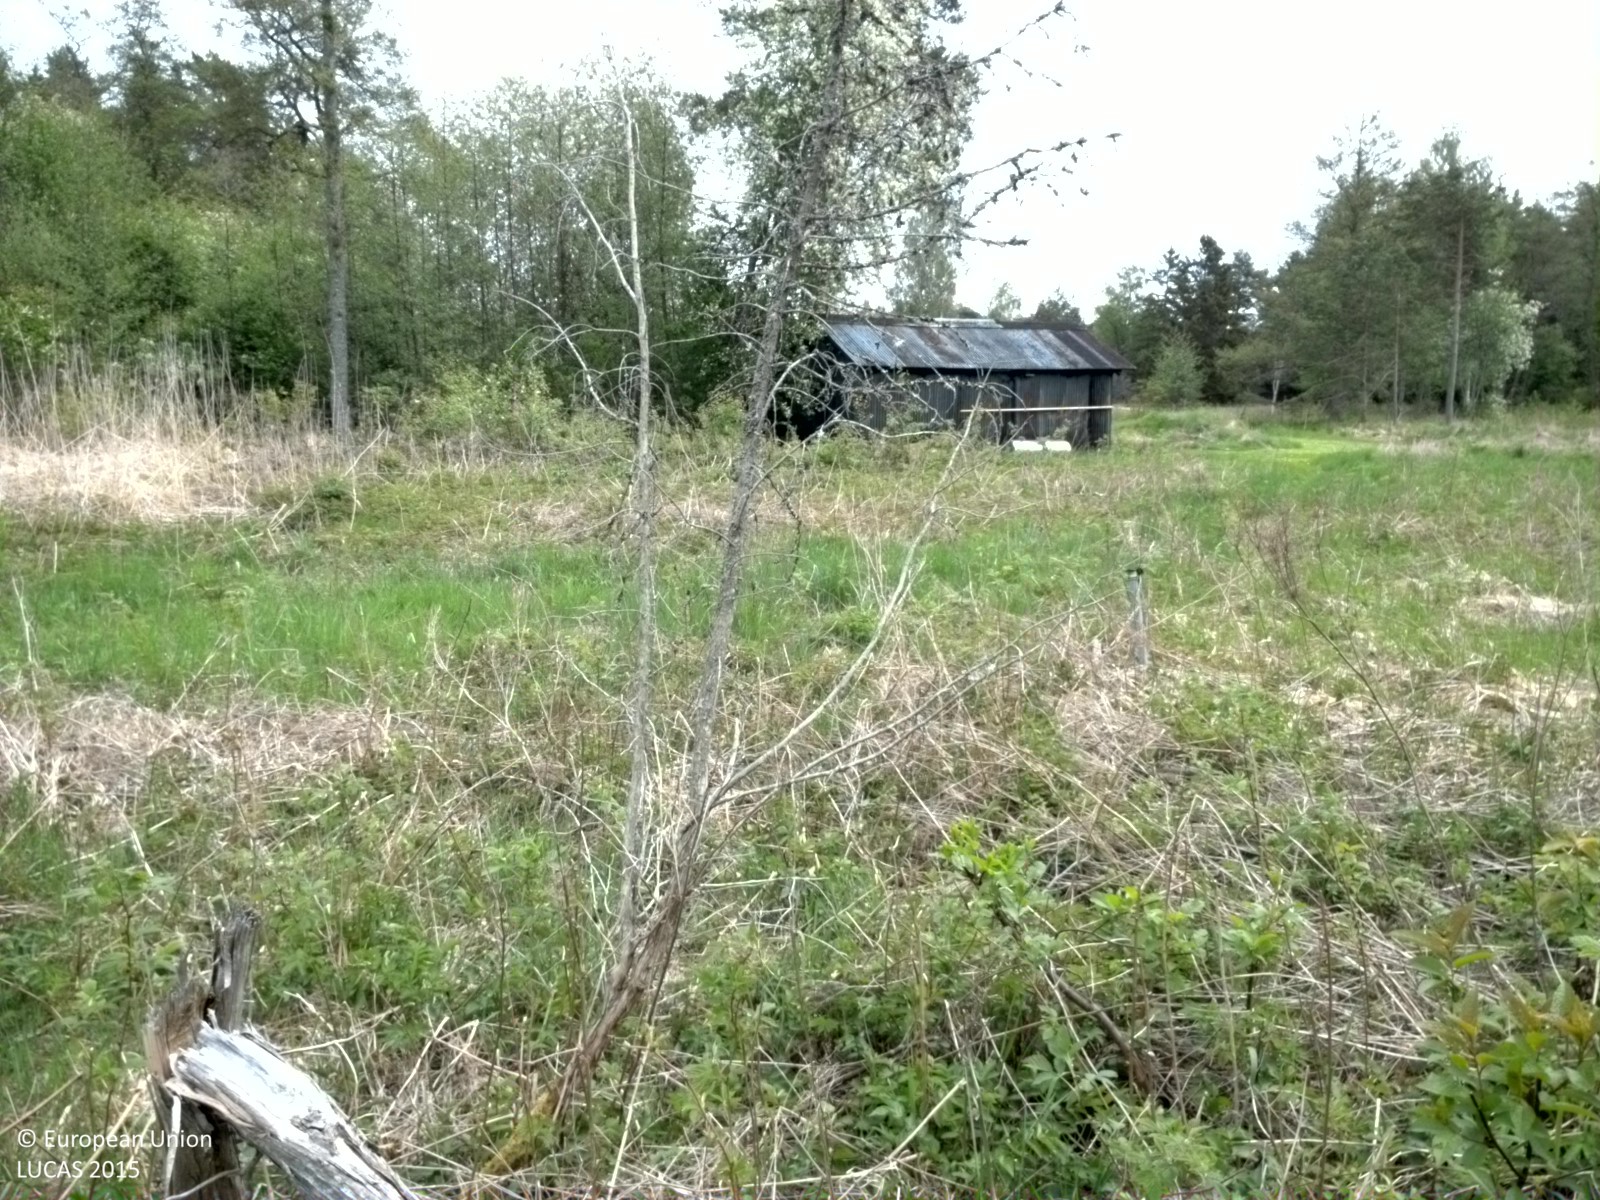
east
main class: Shrubland
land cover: Shrubland with sparse tree cover
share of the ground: 50 - 75 %
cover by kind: shrubs 65 %, herbaceous plants 30 %, broadleaved forest trees 5 %
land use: Forestry
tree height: < 5 m
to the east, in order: Shrubland with sparse tree cover; Electric lines; Grassland with sparse tree/shrub cover; Shrubland with sparse tree cover; Artificial constructions in urban areas; Grassland without tree/shrub cover; Tracks; Grass margins; Ditches and canals; Fences; Grassland without tree/shrub cover; Ditches and canals; Grassland with sparse tree/shrub cover; Pine dominated mixed woodland
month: May
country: SE
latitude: 60.3411
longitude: 18.4927
